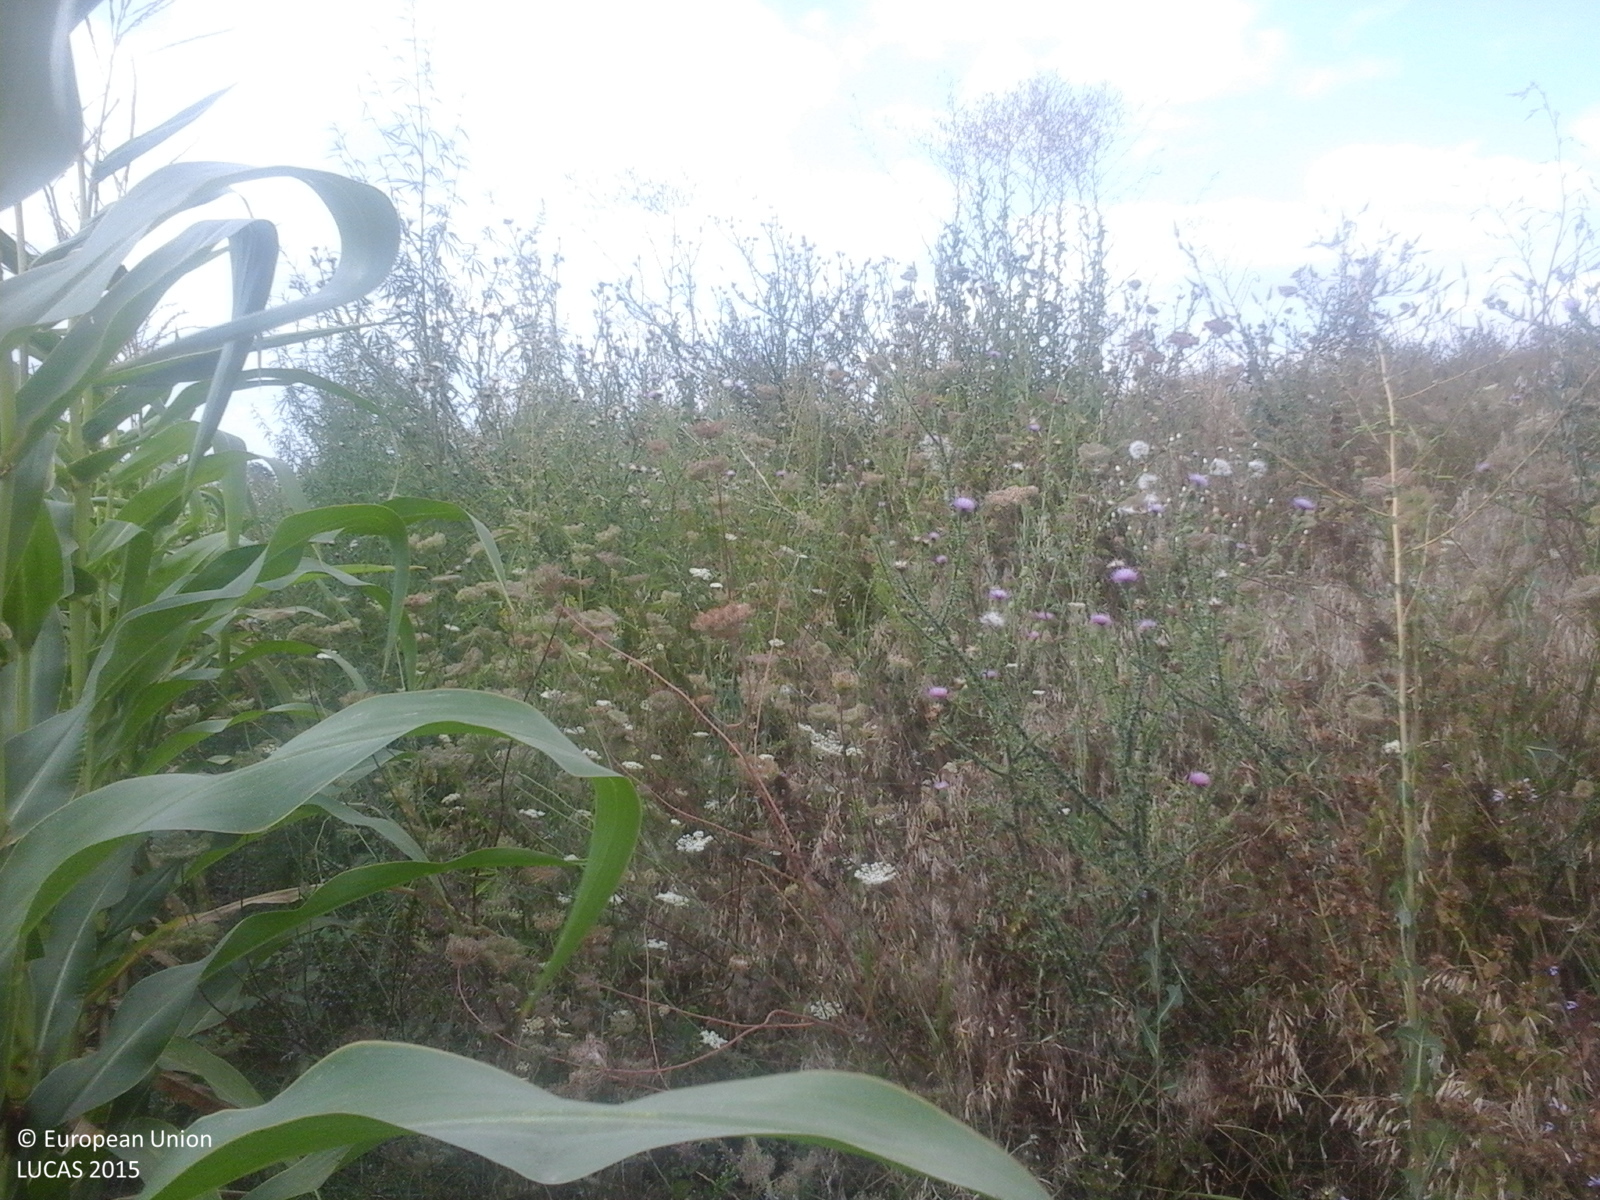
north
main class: Cropland
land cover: Maize
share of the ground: > 75 %
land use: Agriculture (excluding fallow land and kitchen gardens)
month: August
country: RO
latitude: 44.6289
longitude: 28.2813
